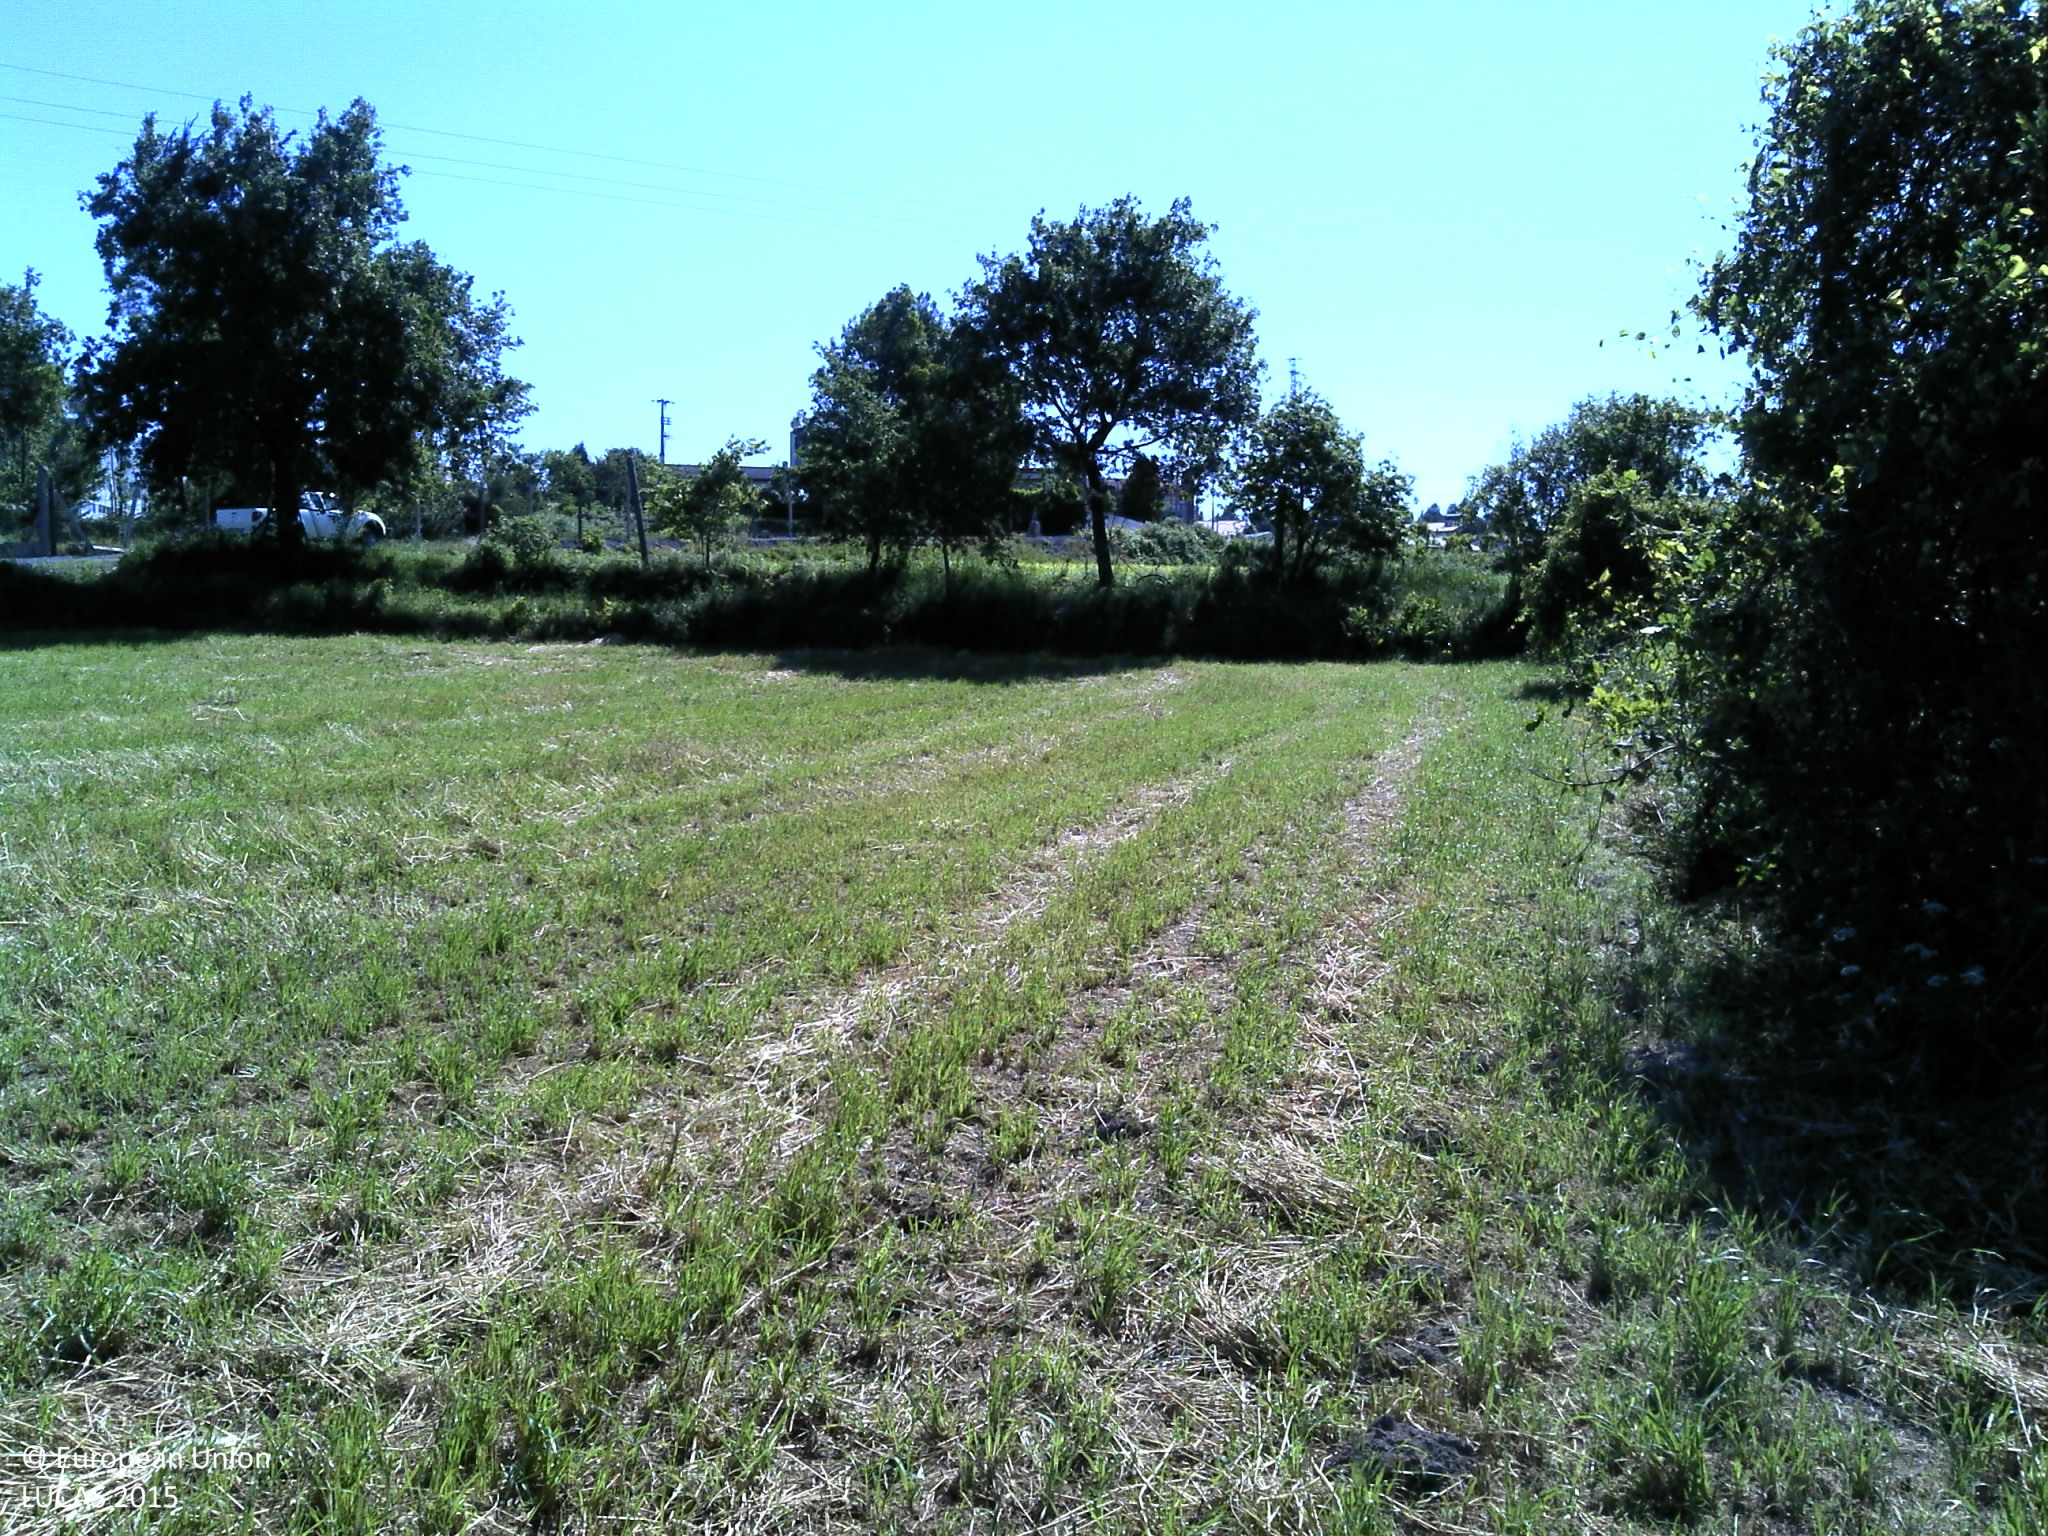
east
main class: Cropland
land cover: Temporary grasslands
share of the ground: 25 - 50 %
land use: Agriculture (excluding fallow land and kitchen gardens)
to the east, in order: Temporary grasslands; Abandoned hedges; Grass margins; Maize; Electric lines; Maize; Grass margins; Dry stone walls; Vineyards; Tracks; Vineyards; Other bare soil; Electric lines; Other bare soil; Artificial constructions in urban areas
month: May
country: PT
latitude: 41.3000
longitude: -8.6067
